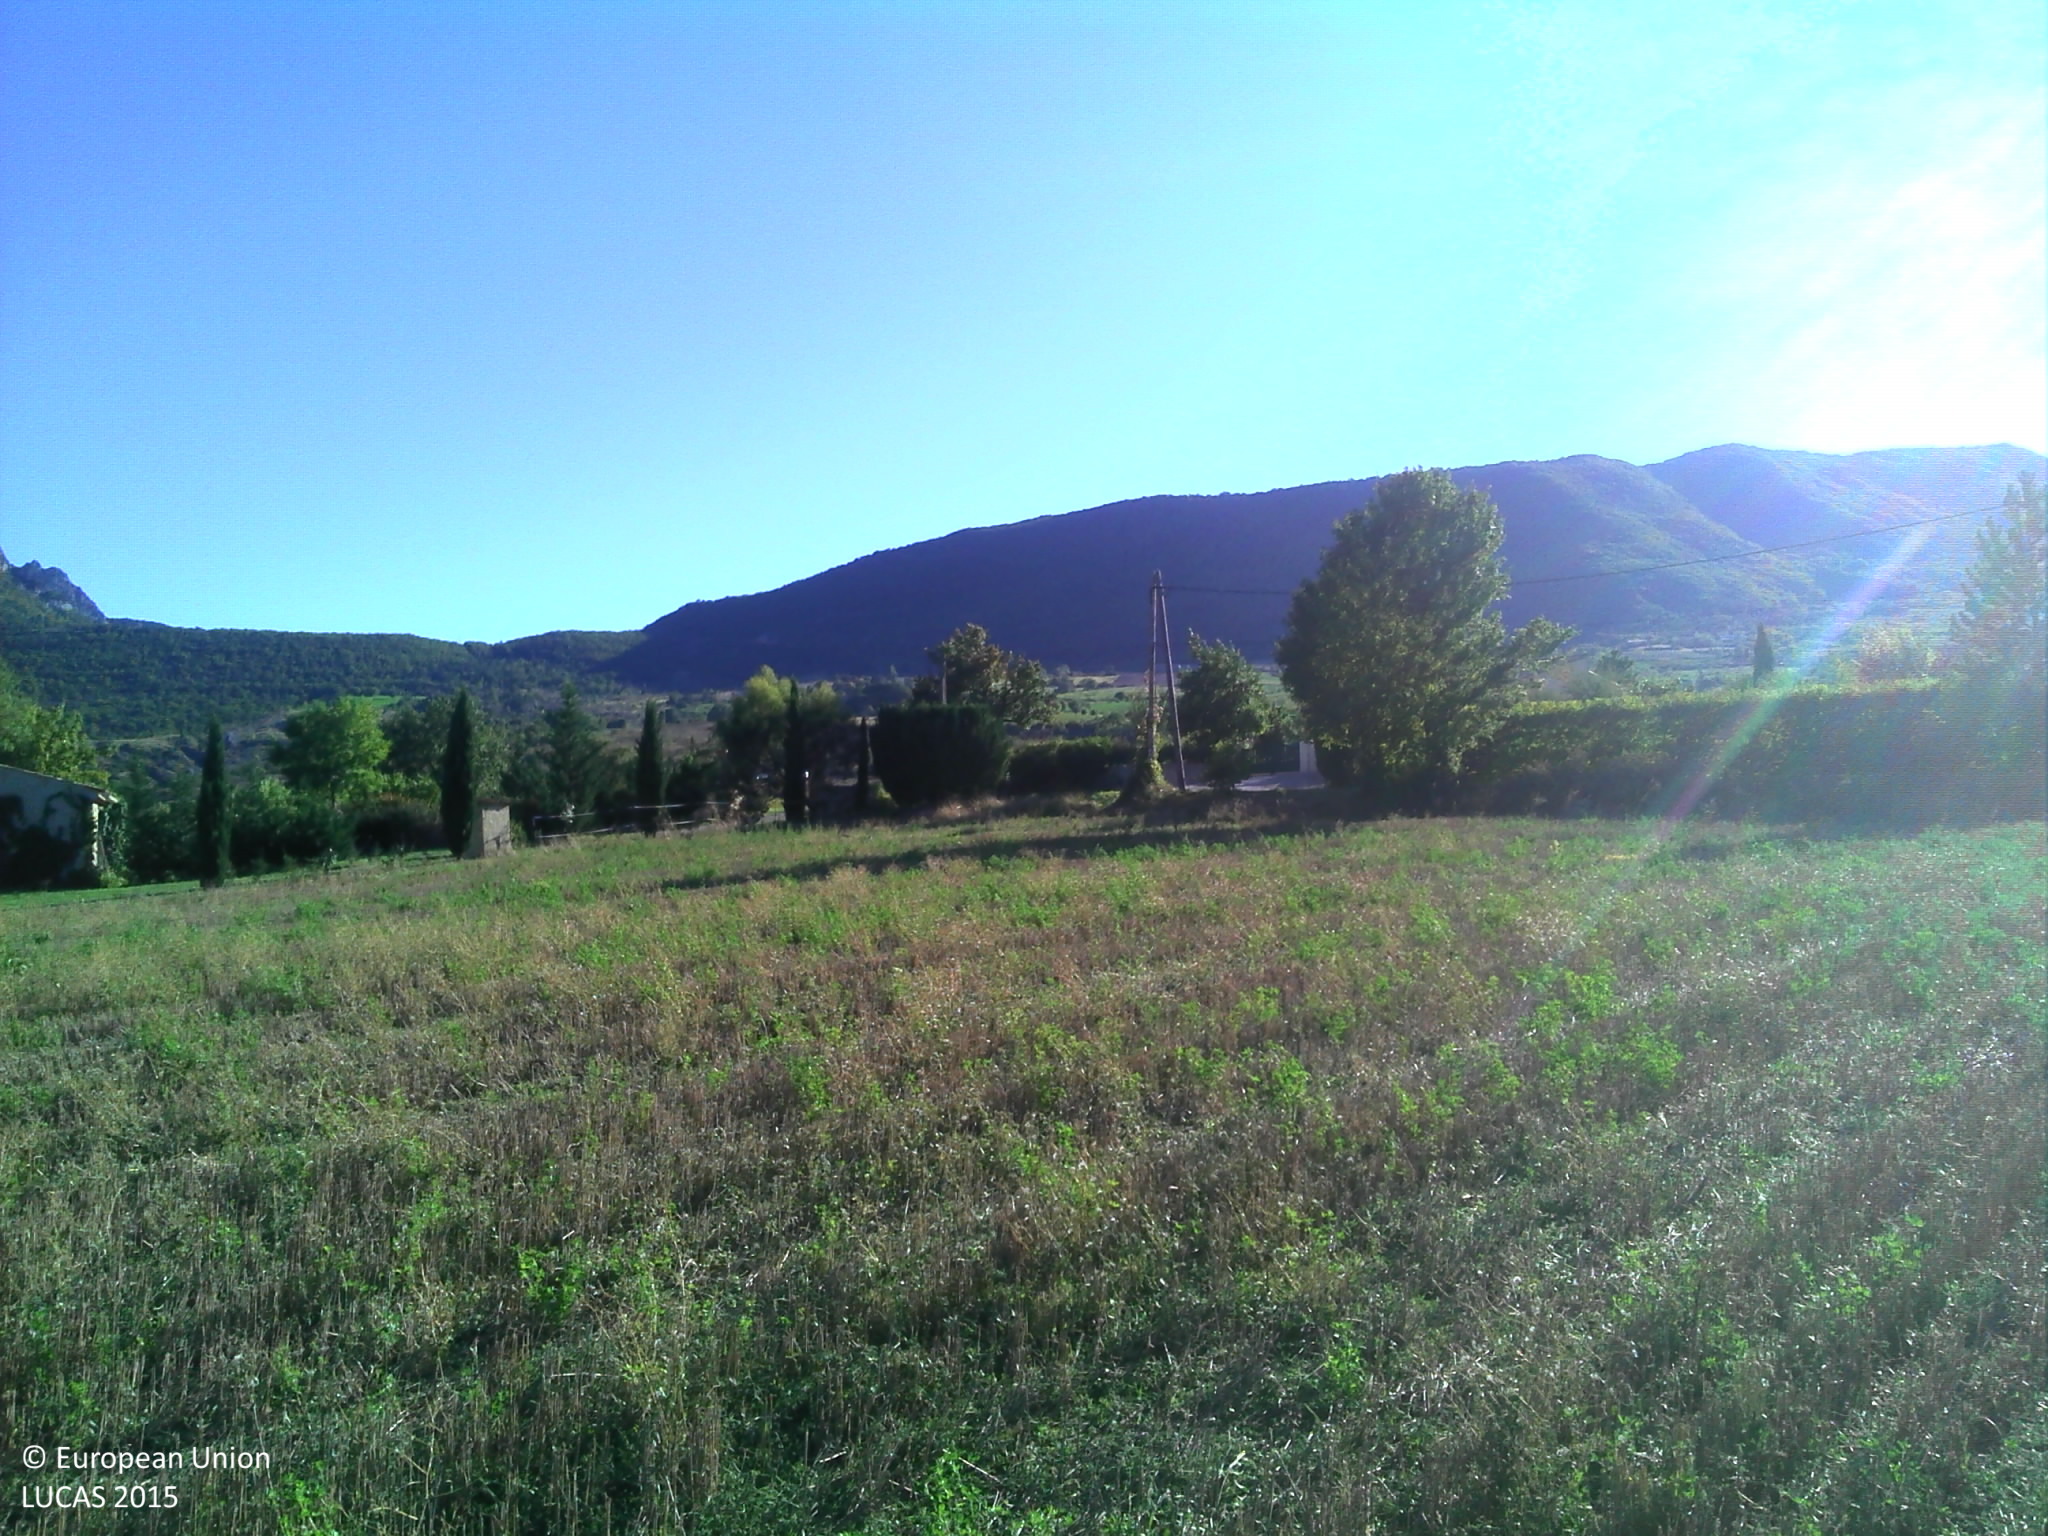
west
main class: Cropland
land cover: Common wheat
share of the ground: > 75 %
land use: Agriculture (excluding fallow land and kitchen gardens)
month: September
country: FR
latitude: 44.3335
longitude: 5.2794
